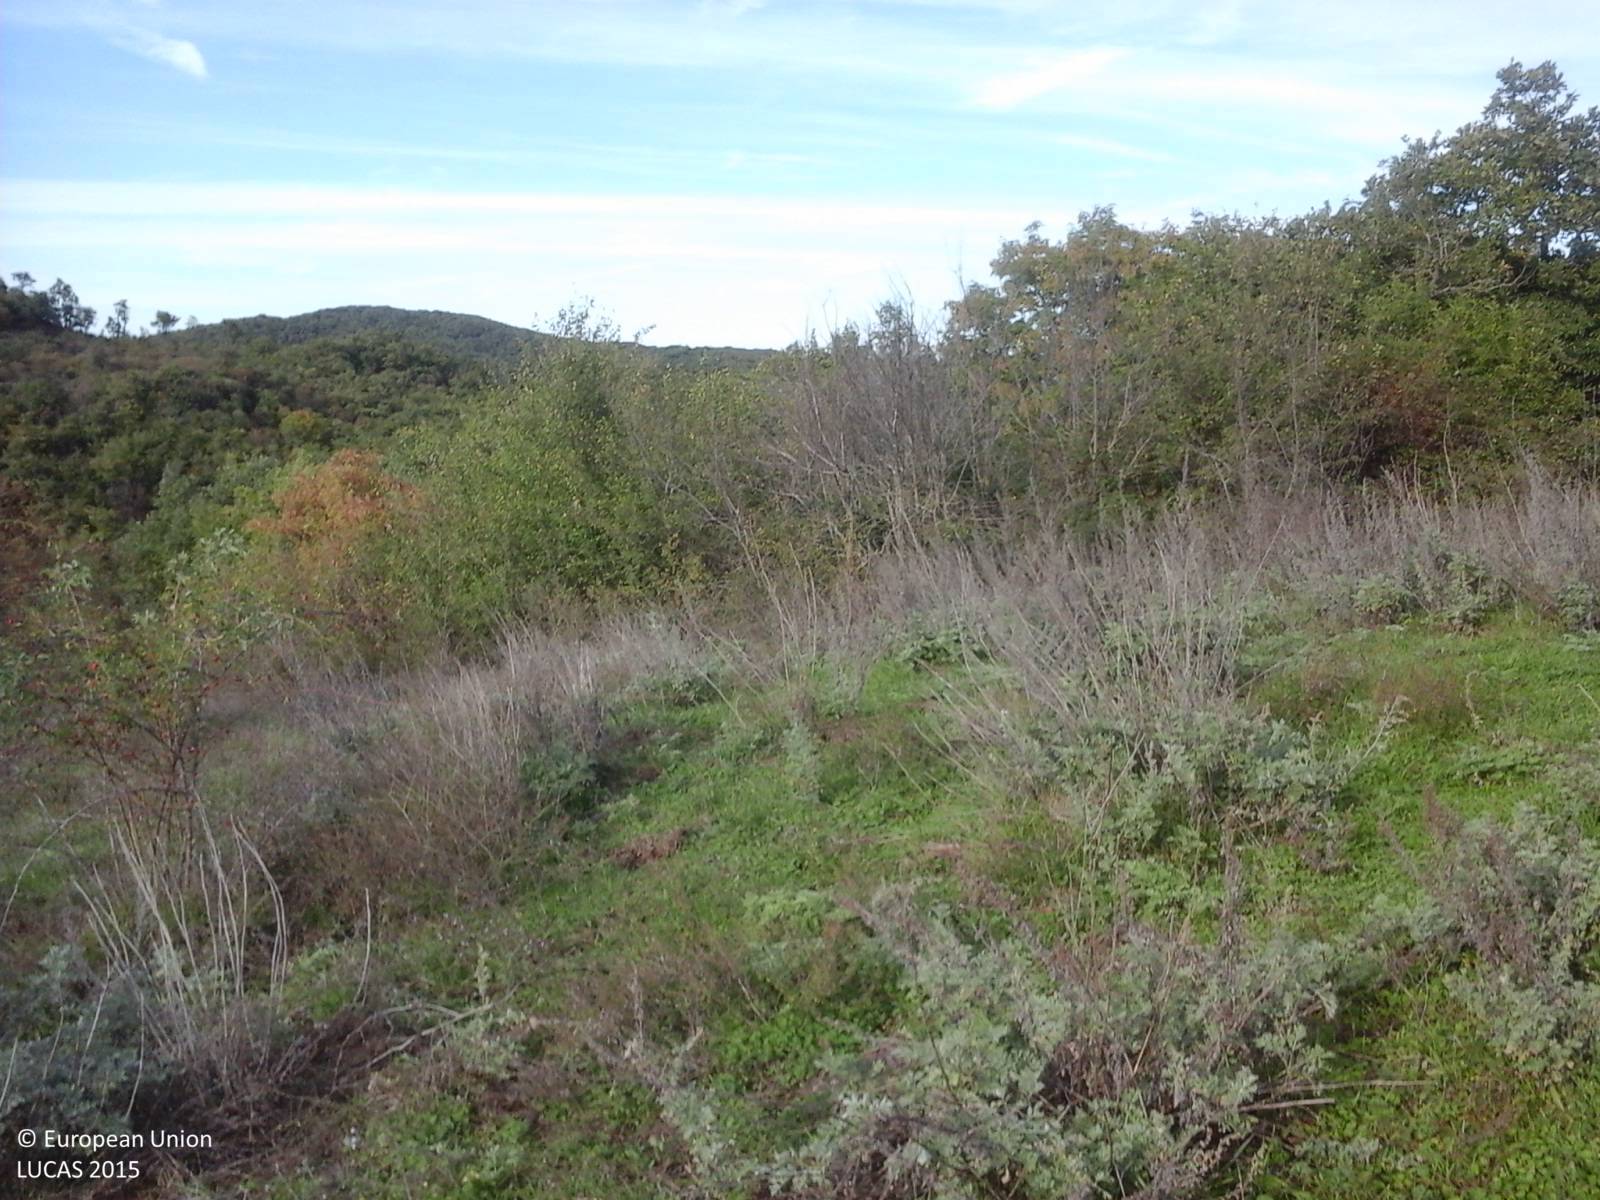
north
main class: Woodland
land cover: Broadleaved woodland
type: thermophilous deciduous forest
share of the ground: > 75 %
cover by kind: broadleaved forest trees 100 %
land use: Forestry
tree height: > 5 m
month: October
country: IT
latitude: 42.8276
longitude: 12.2560
